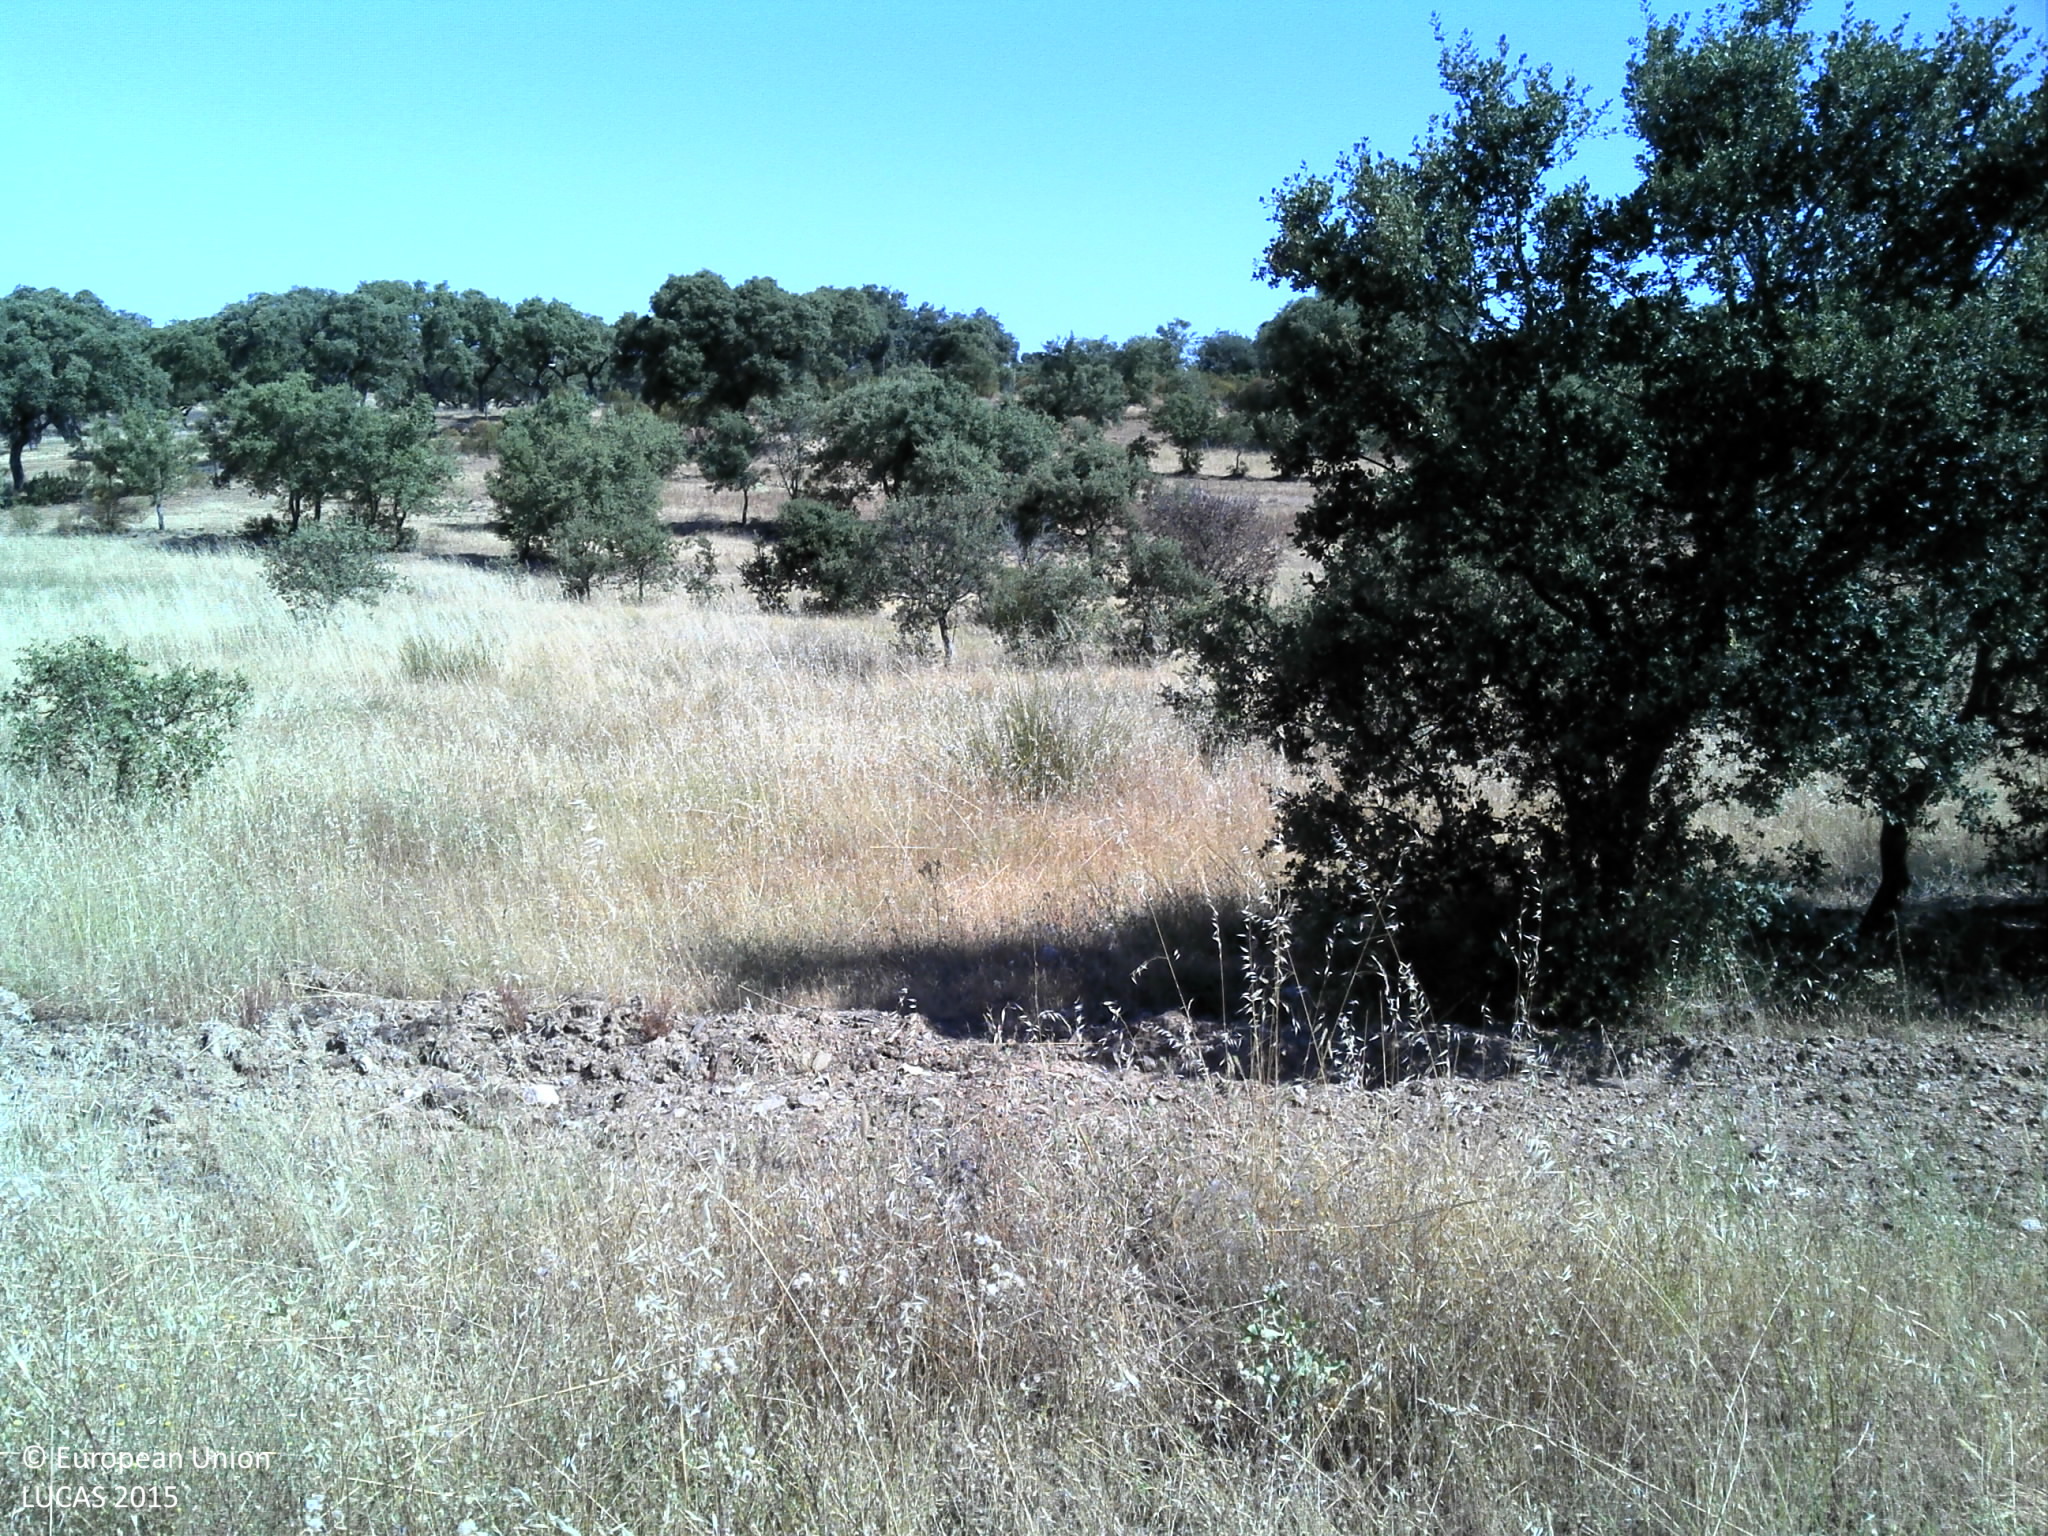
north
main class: Grassland
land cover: Grassland with sparse tree/shrub cover
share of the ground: < 10 %
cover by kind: herbaceous plants 85 %, unconsolidated bare surface 10 %, broadleaved forest trees 5 %
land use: Agriculture (excluding fallow land and kitchen gardens)
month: June
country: PT
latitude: 37.7000
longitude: -7.6068
